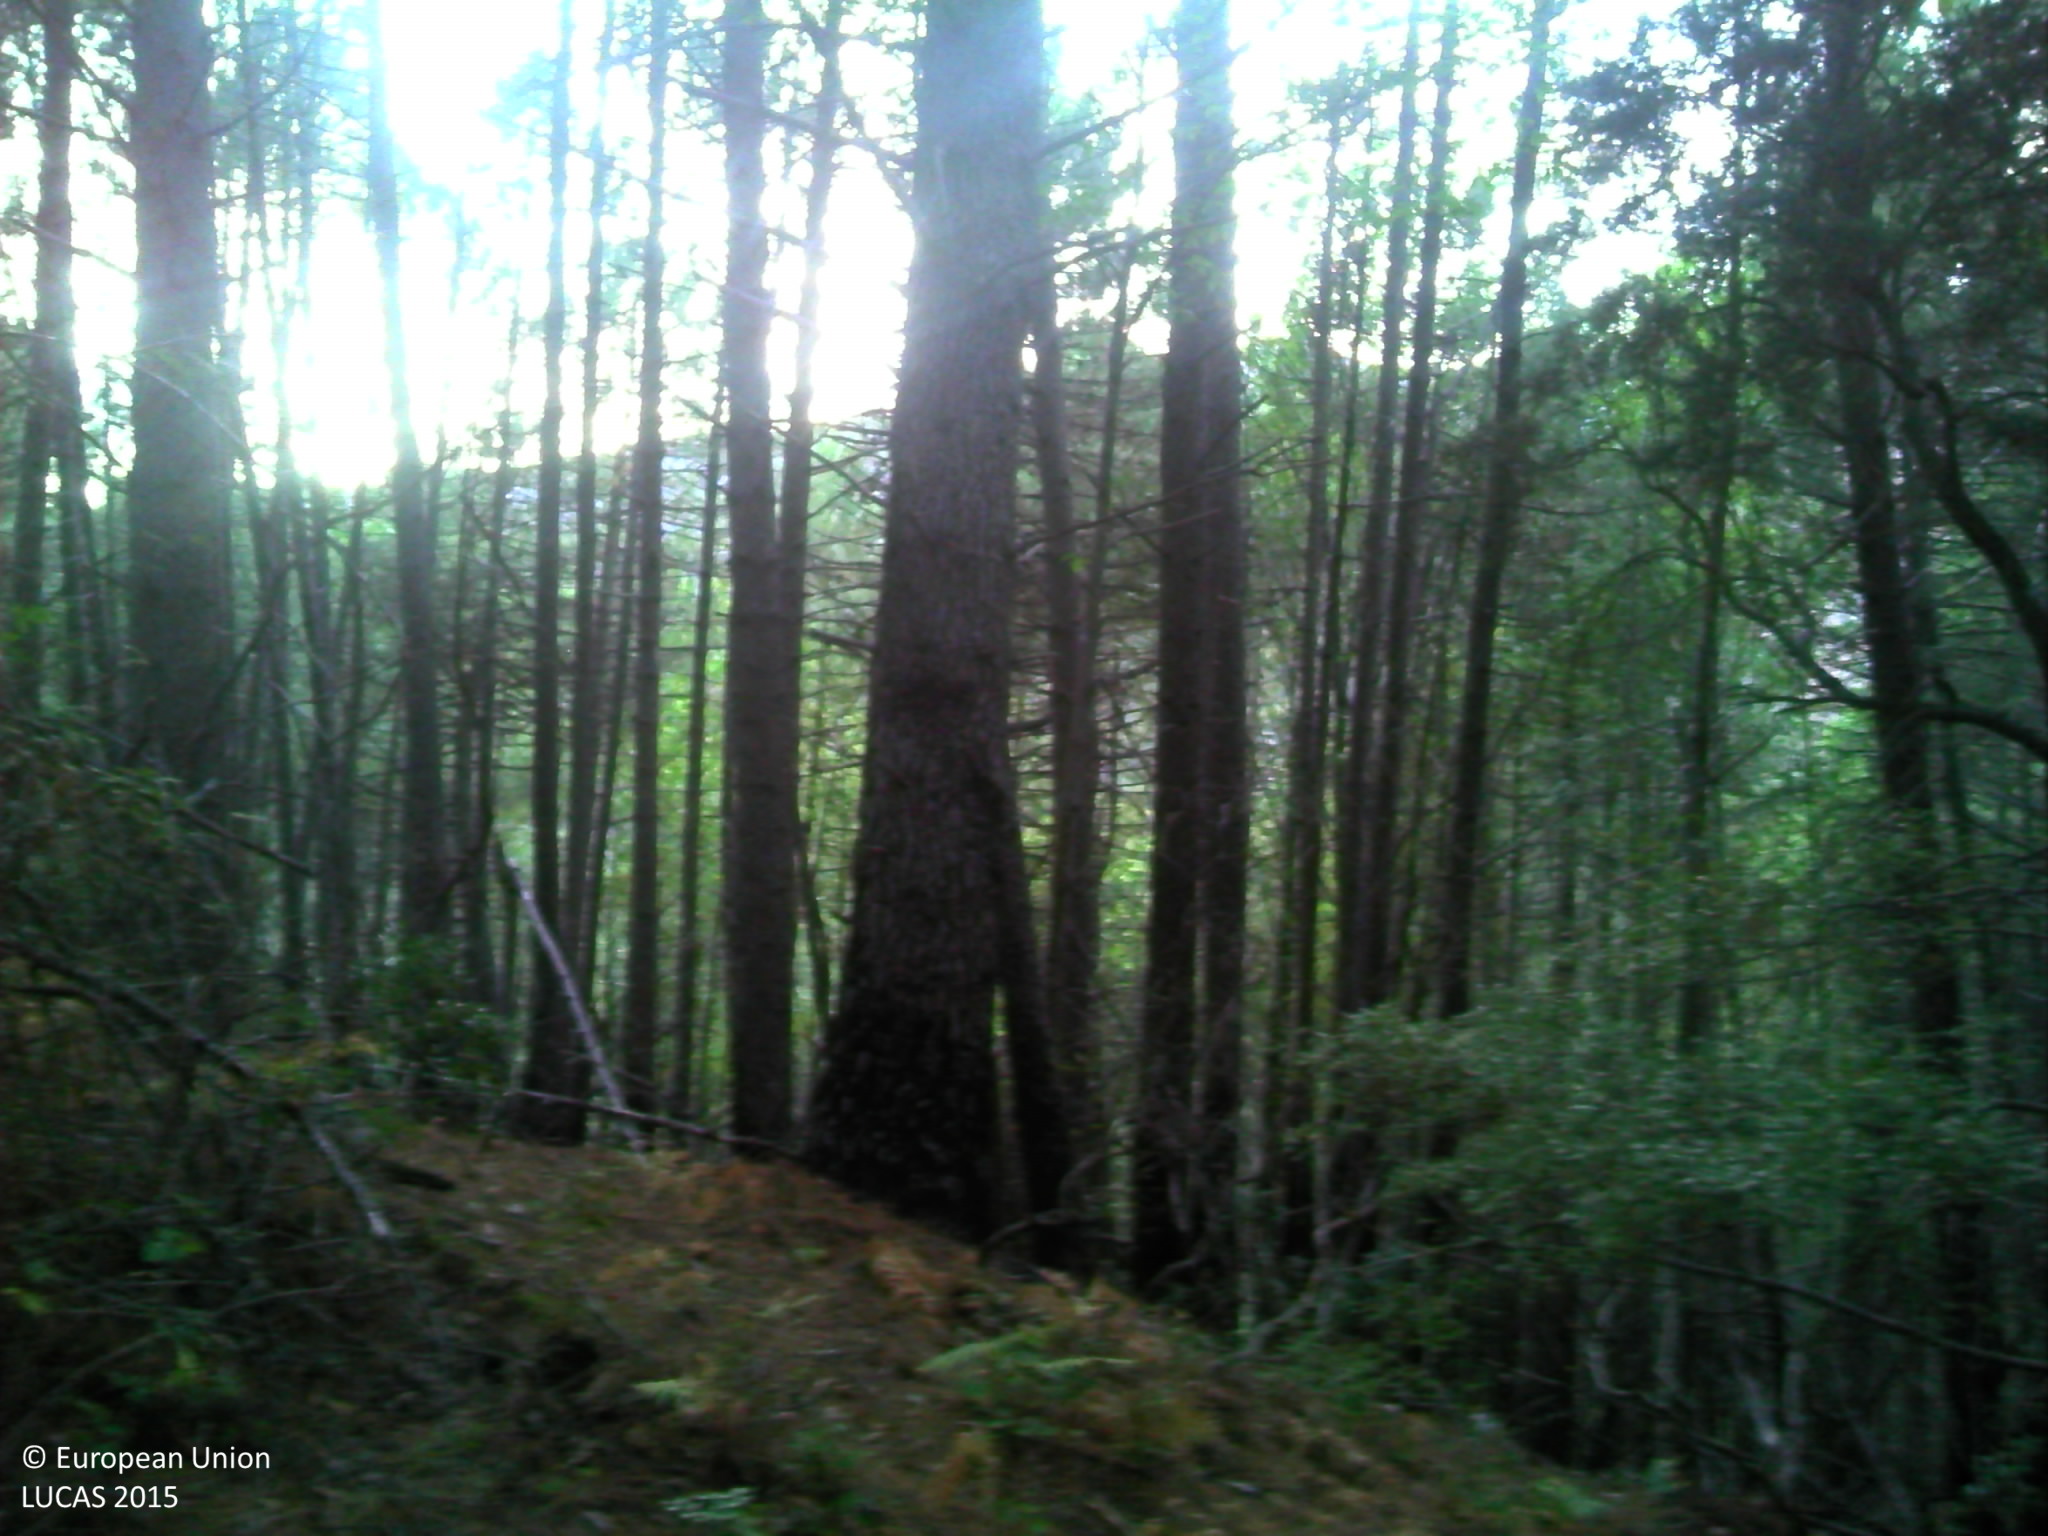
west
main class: Woodland
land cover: Pine dominated coniferous woodland
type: coniferous forest of the mediterranean region
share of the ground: > 75 %
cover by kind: coniferous forest trees 90 %, broadleaved forest trees 5 %, herbaceous plants 5 %
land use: Semi-natural and natural areas not in use
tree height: > 5 m
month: September
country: FR
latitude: 41.7825
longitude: 9.0772
